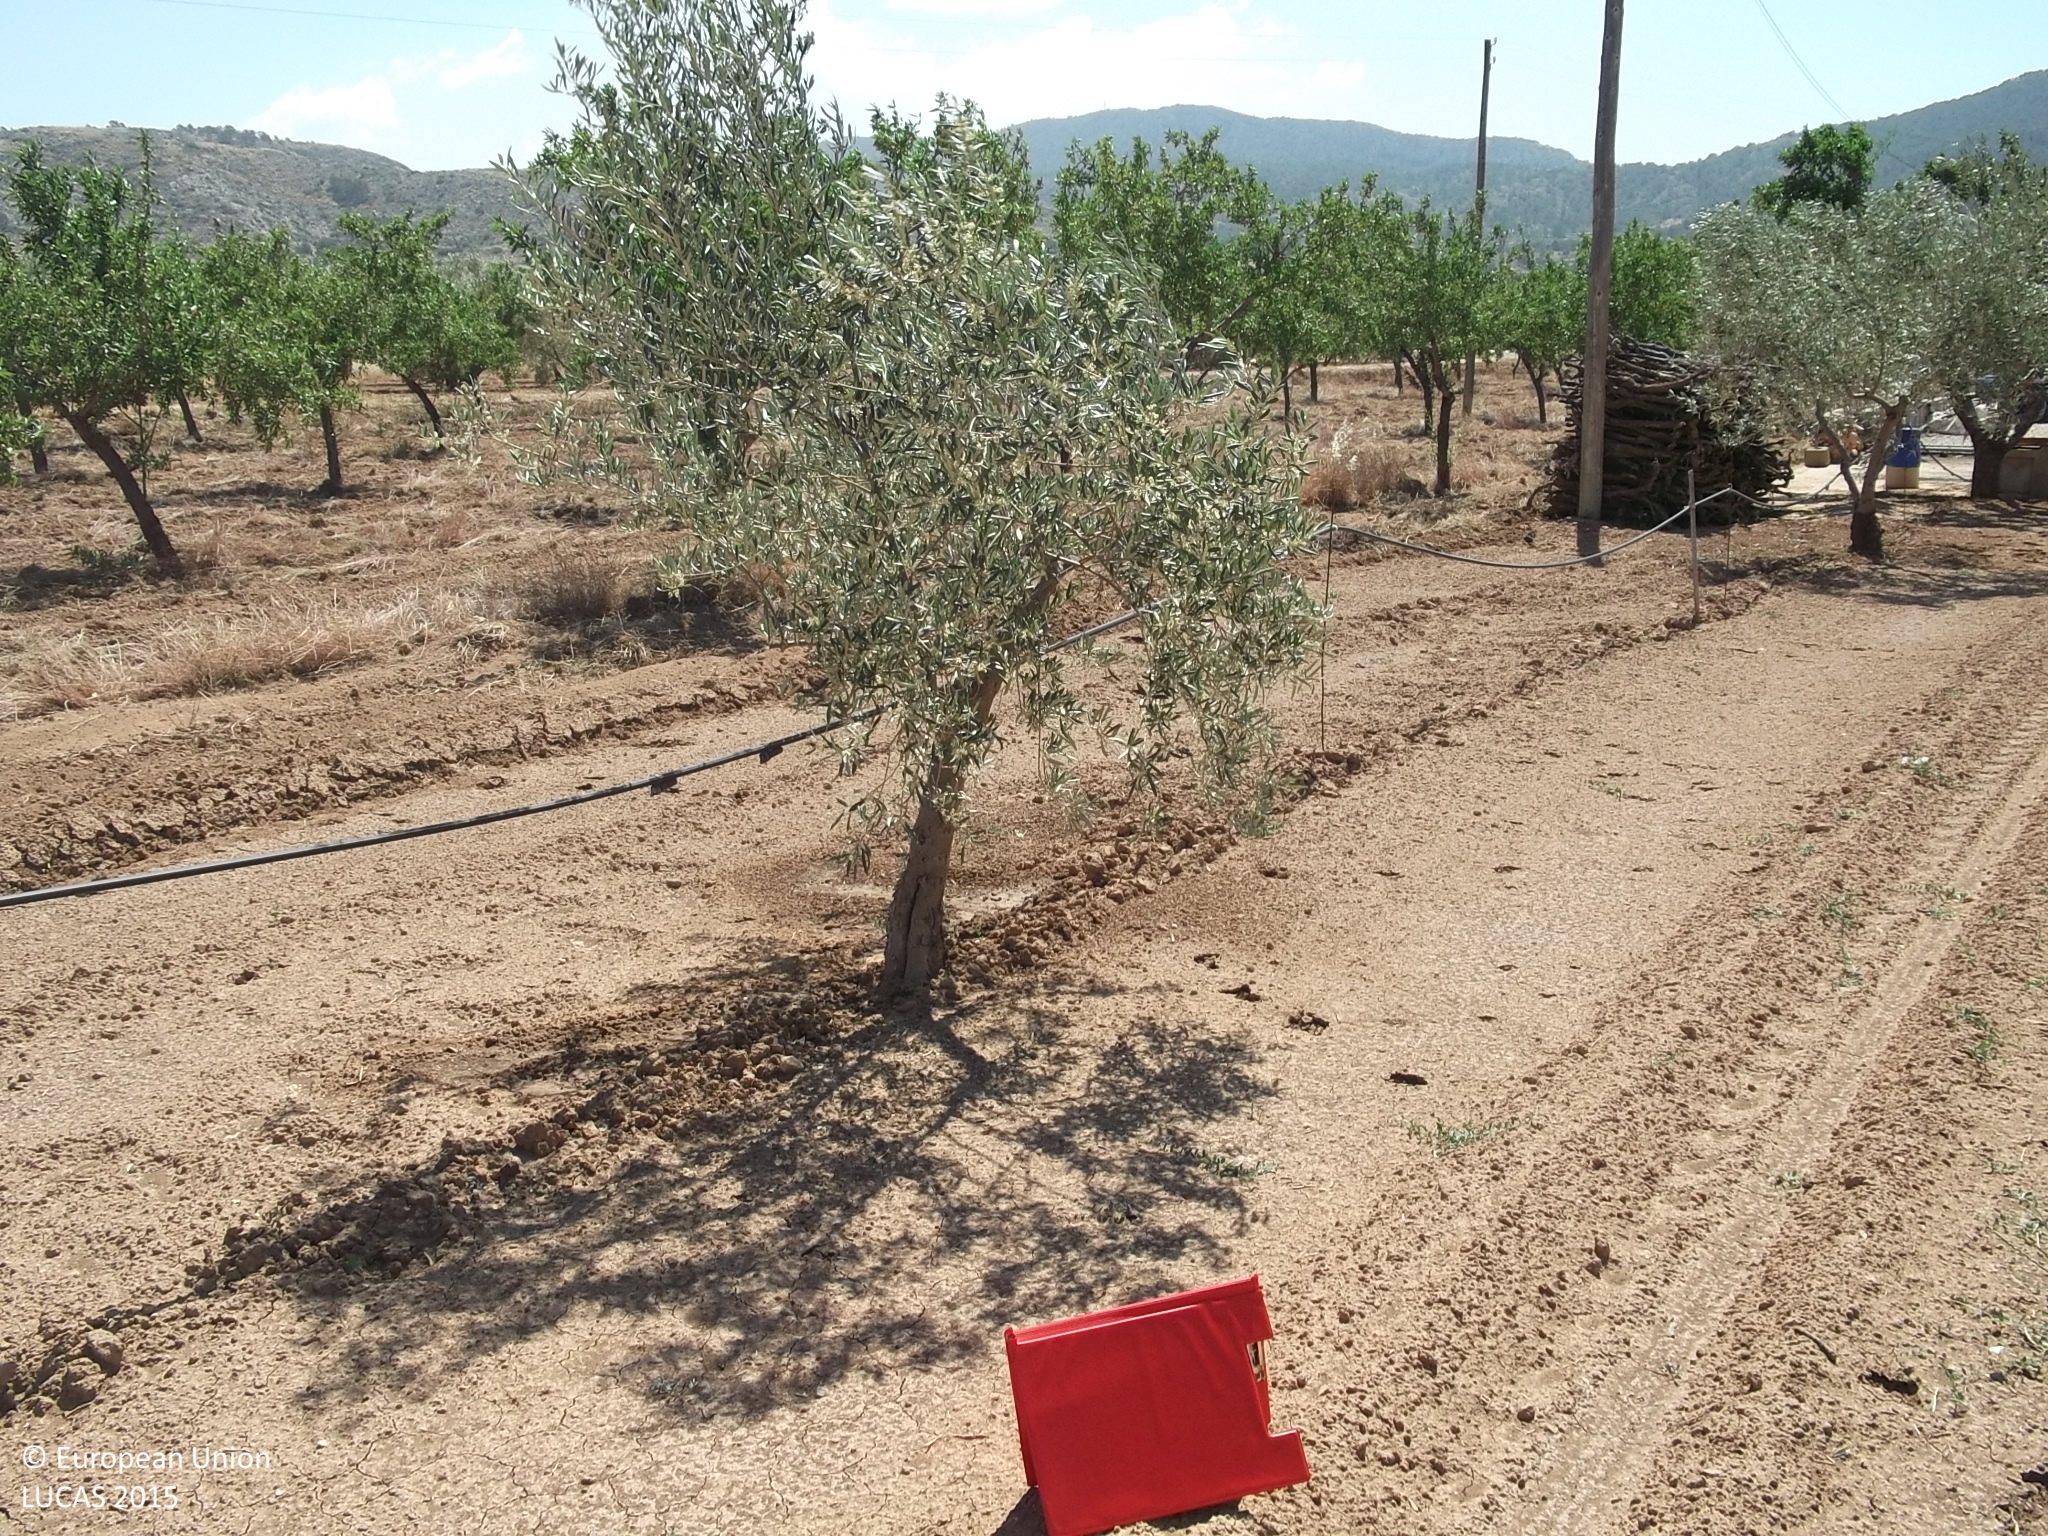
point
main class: Cropland
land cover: Nuts trees
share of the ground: 10 - 25 %
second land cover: Olive groves
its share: 10 - 25 %
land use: Agriculture (excluding fallow land and kitchen gardens)
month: May
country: ES
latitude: 38.2883
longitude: -0.9049
